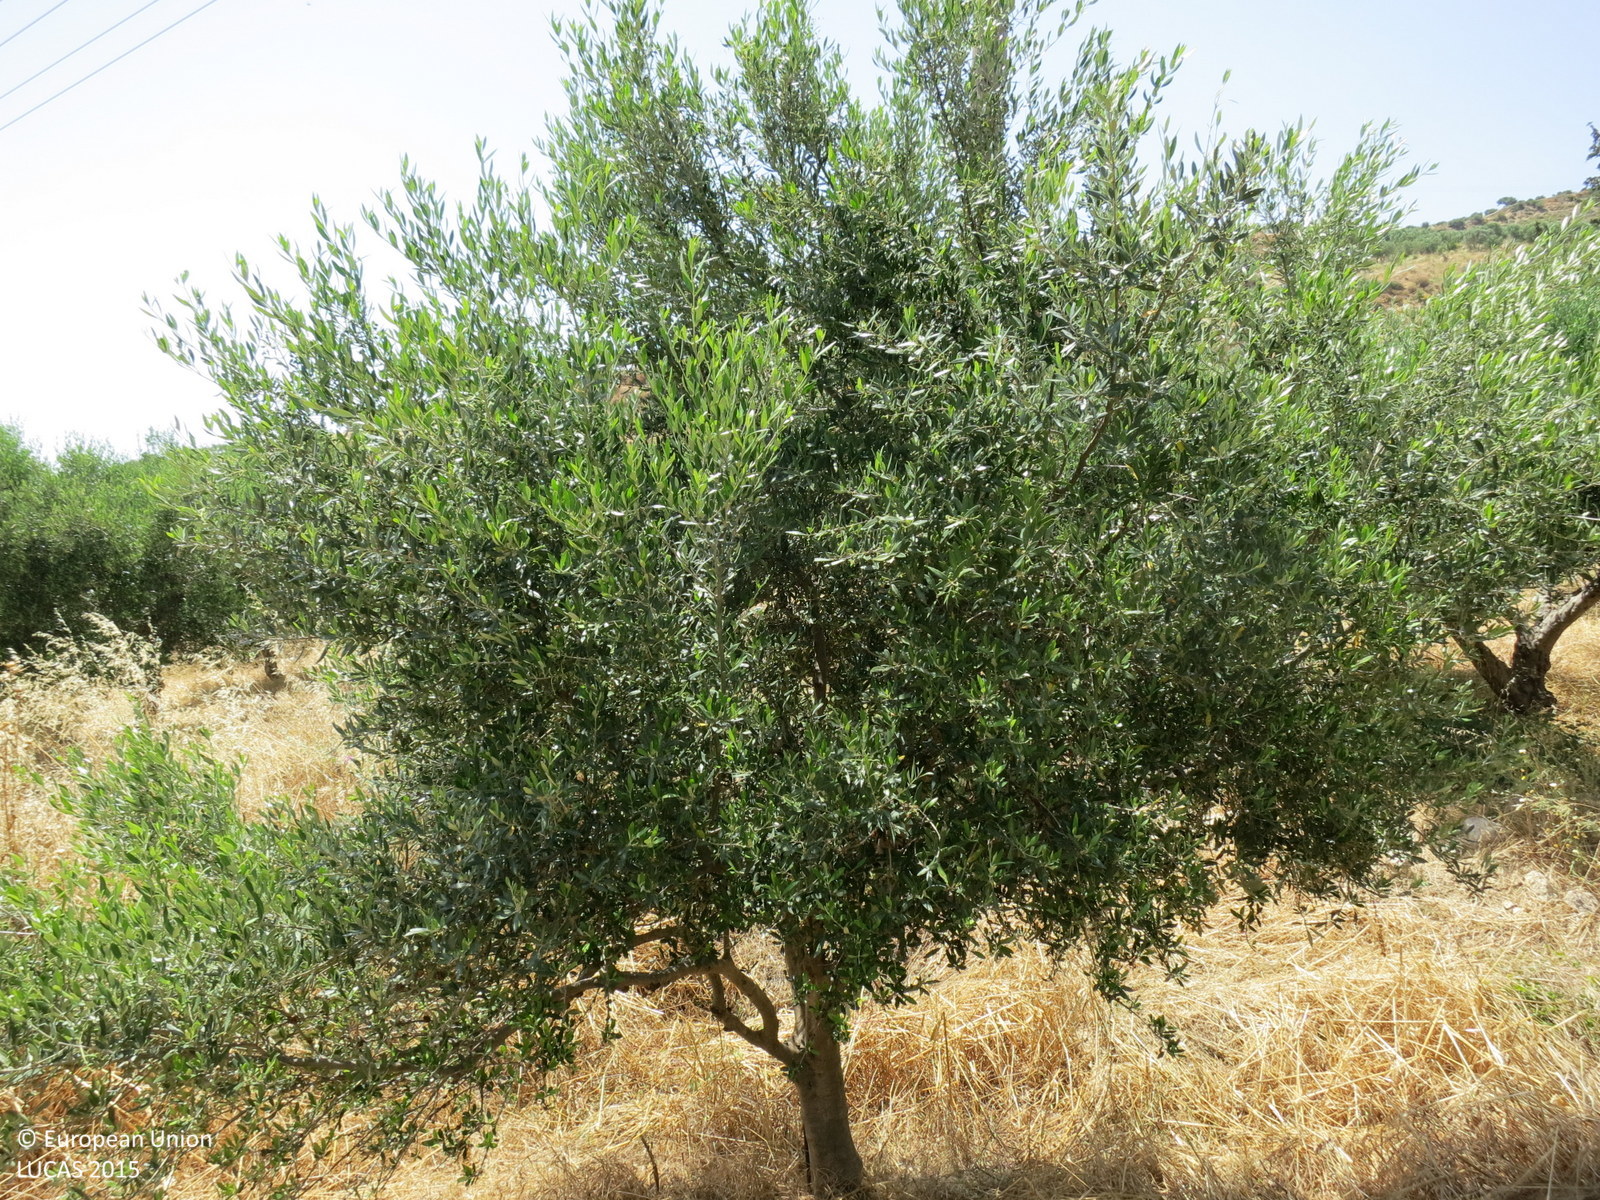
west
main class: Cropland
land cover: Olive groves
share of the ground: 25 - 50 %
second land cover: Spontaneously vegetated surfaces
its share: > 75 %
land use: Agriculture (excluding fallow land and kitchen gardens)
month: June
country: GR
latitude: 35.0976
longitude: 24.9825
